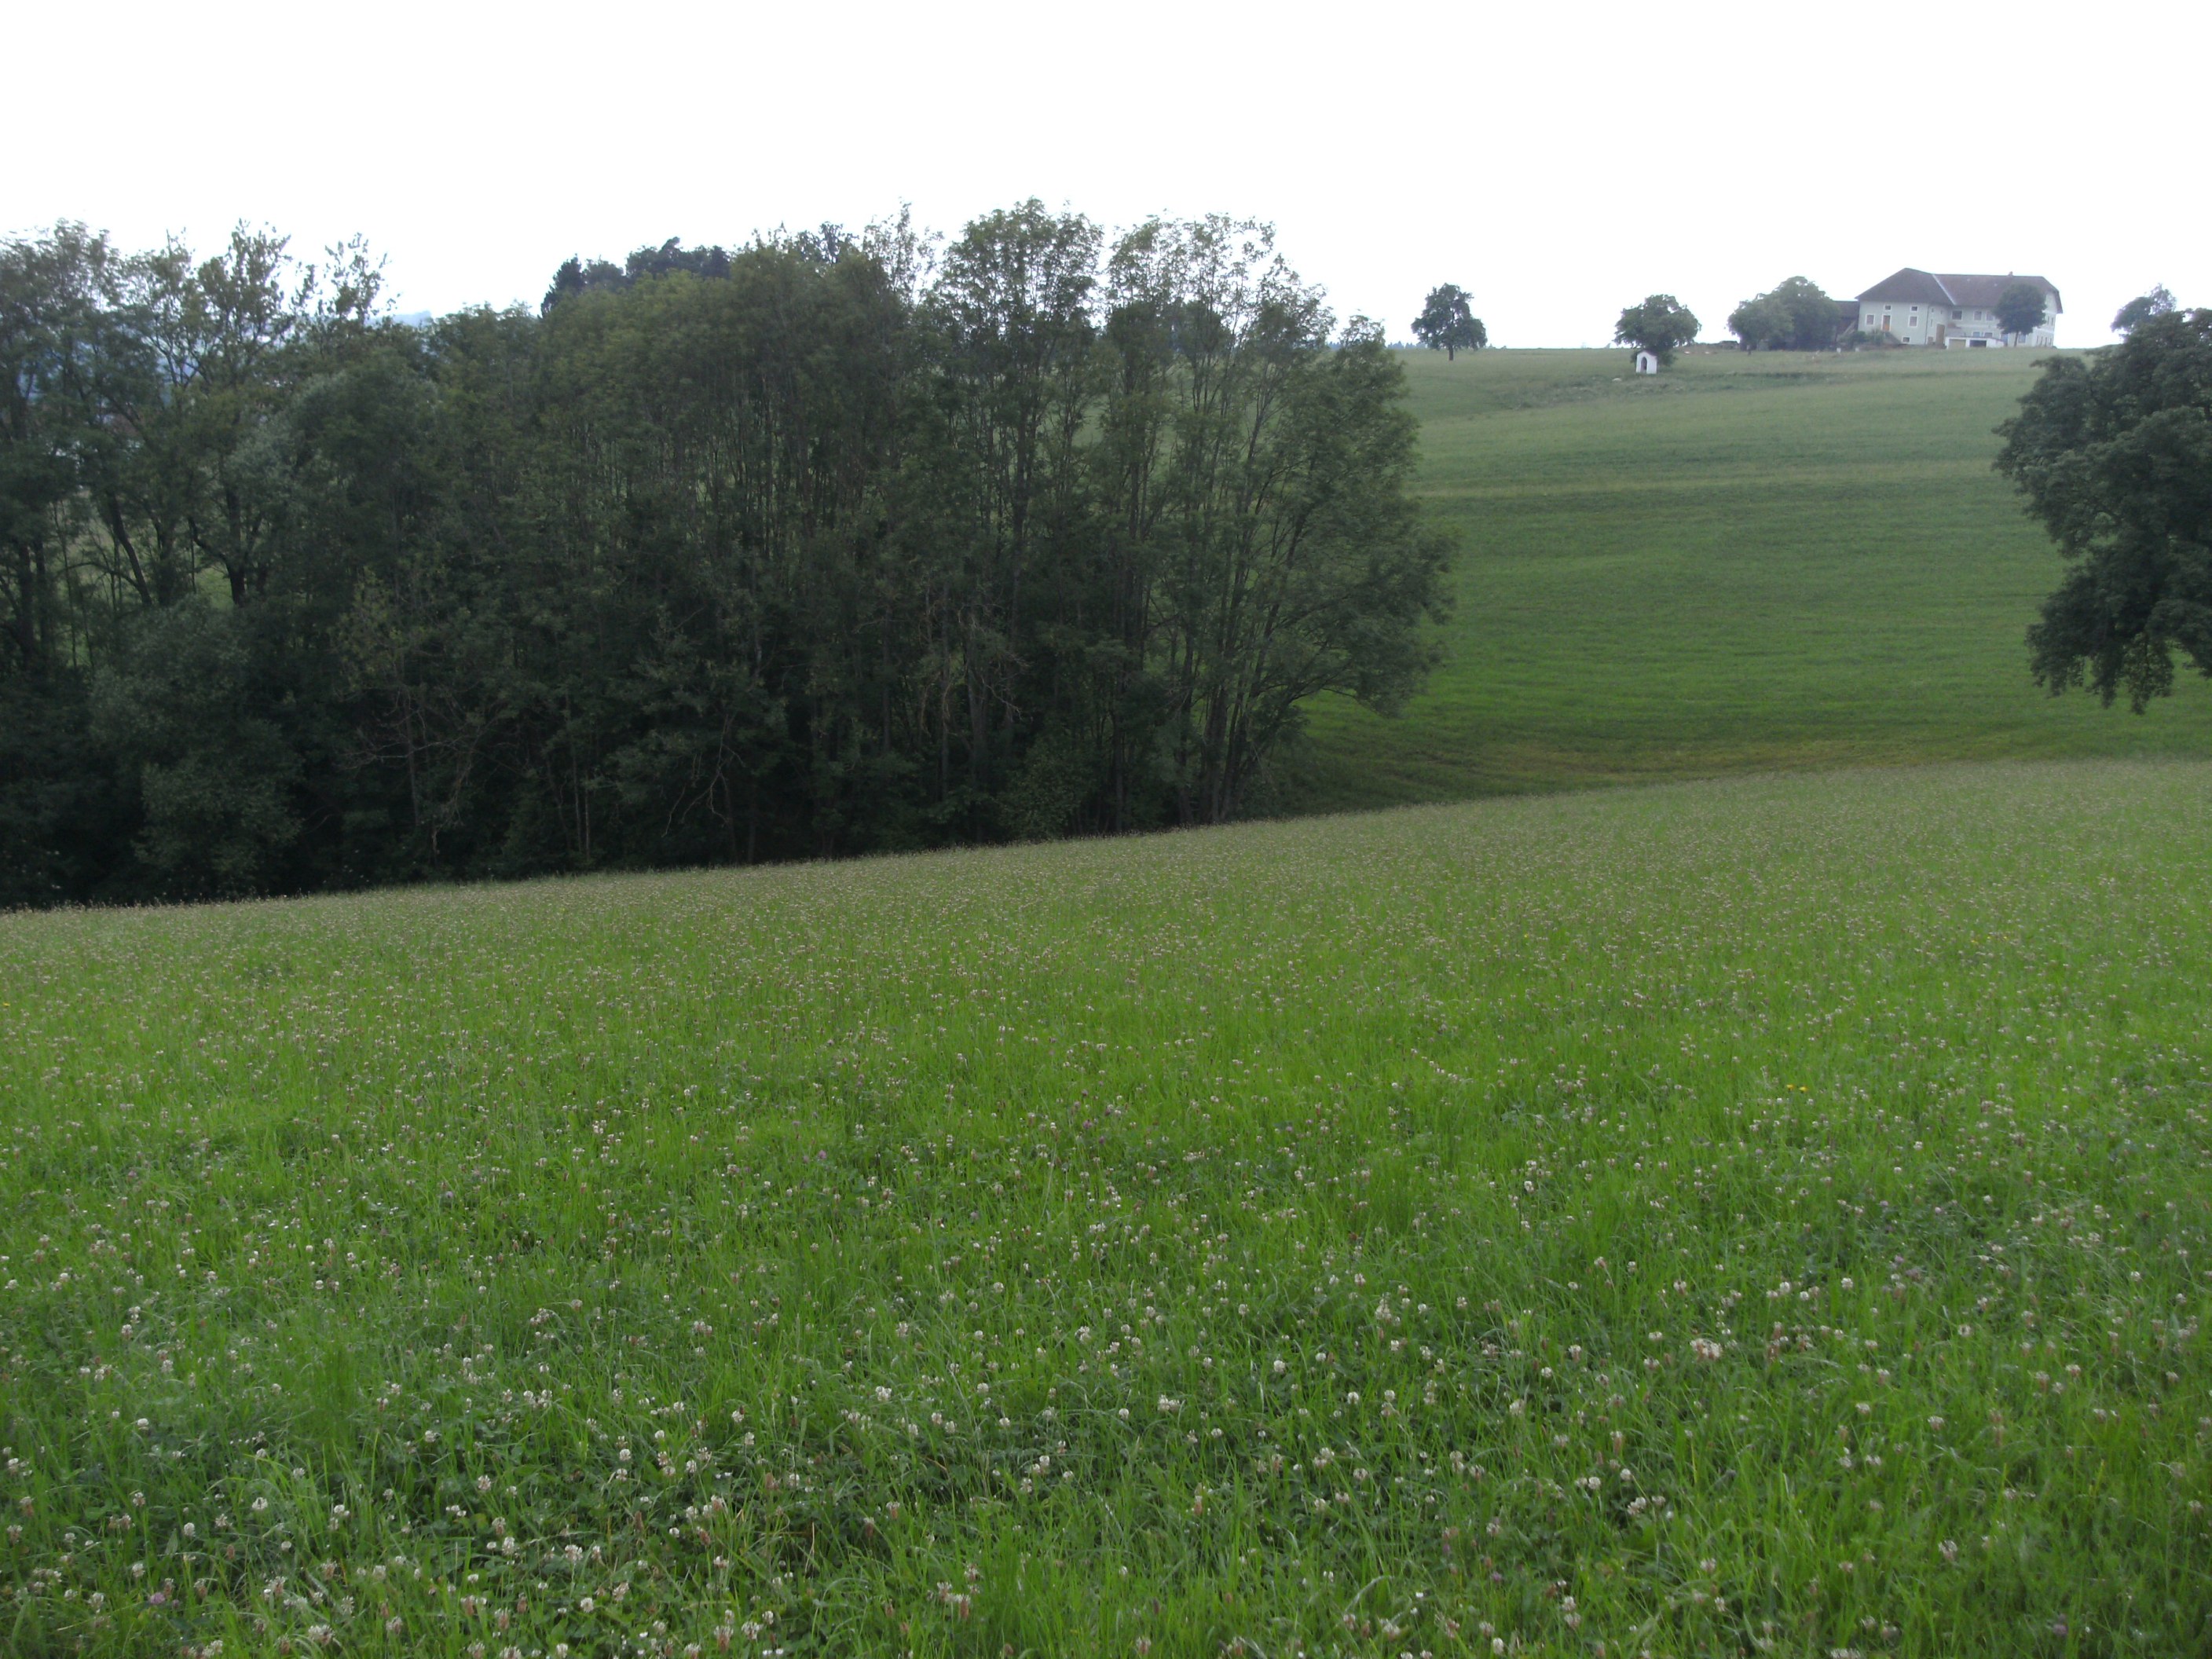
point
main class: Grassland
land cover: Grassland without tree/shrub cover
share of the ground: > 75 %
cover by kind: herbaceous plants 100 %
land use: Agriculture (excluding fallow land and kitchen gardens)
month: June
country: AT
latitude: 48.3988
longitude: 14.1196
